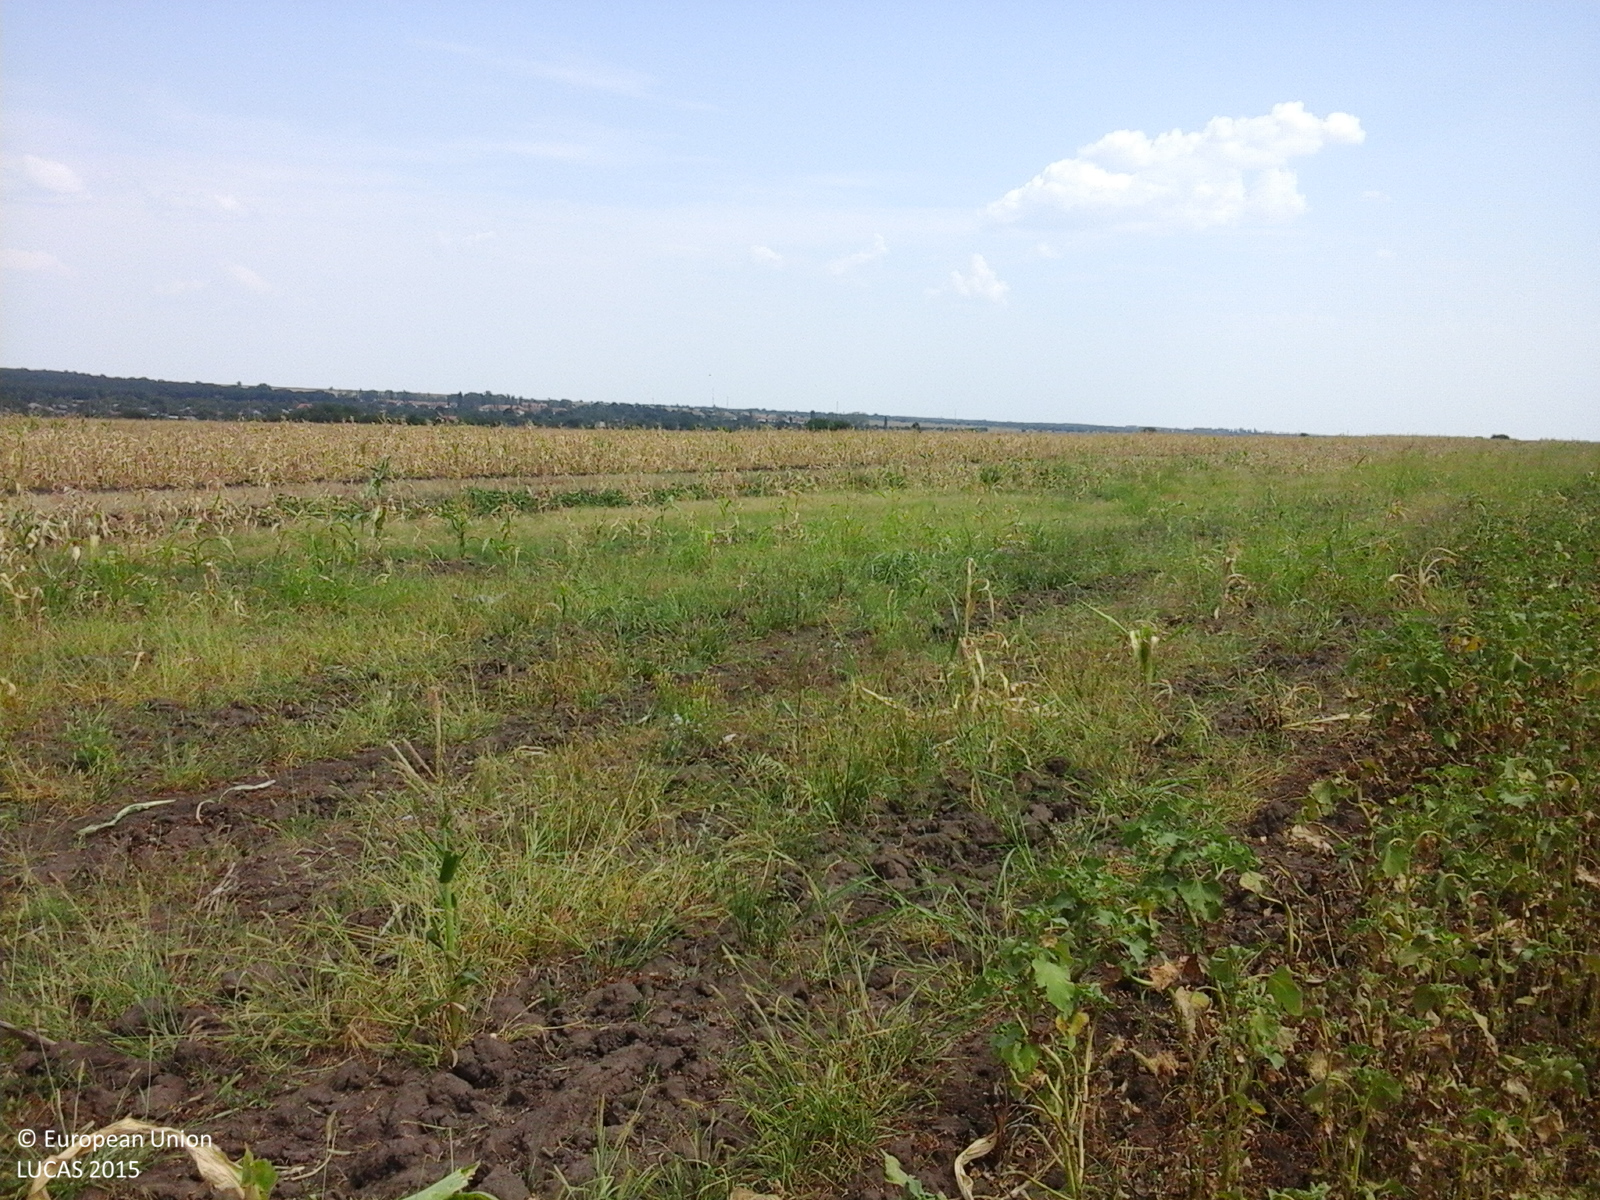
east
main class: Cropland
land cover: Maize
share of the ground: 10 - 25 %
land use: Agriculture (excluding fallow land and kitchen gardens)
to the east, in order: Maize; Common wheat; Maize; Common wheat; Sunflower; Grass margins; Tracks; Common wheat; Maize; Common wheat; Maize; Lucerne; Common wheat
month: August
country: RO
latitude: 44.2245
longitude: 23.1267
